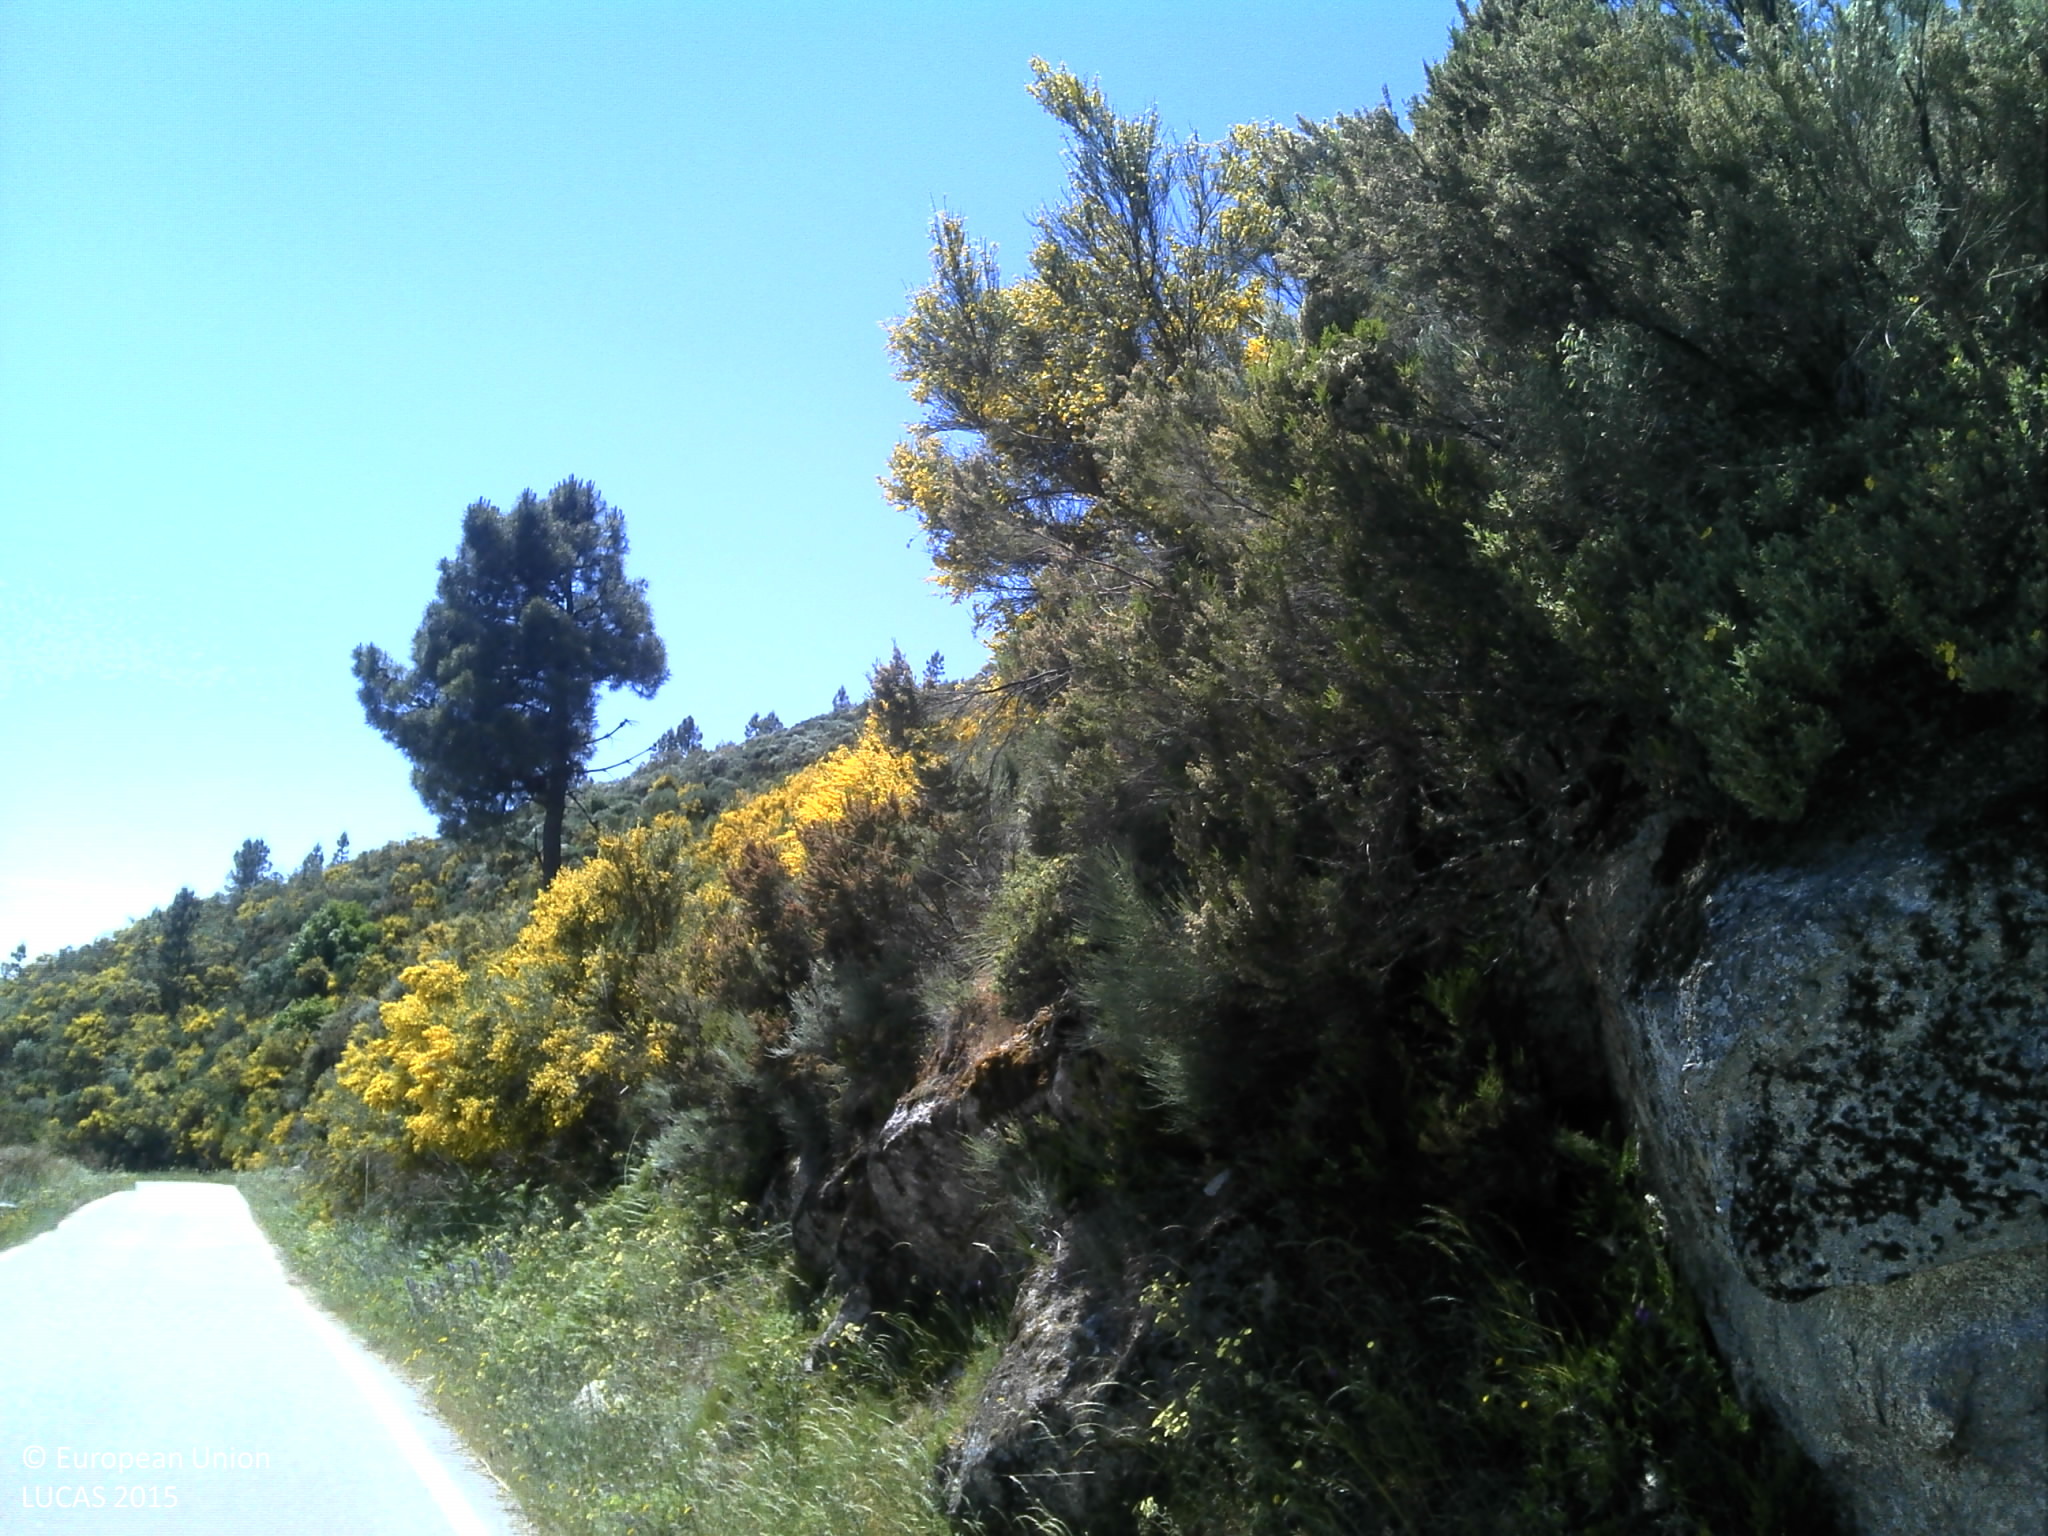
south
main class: Shrubland
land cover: Shrubland without tree cover
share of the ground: 50 - 75 %
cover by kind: shrubs 75 %, unconsolidated bare surface 20 %, herbaceous plants 5 %
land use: Semi-natural and natural areas not in use
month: May
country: PT
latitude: 40.4634
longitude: -7.3364
